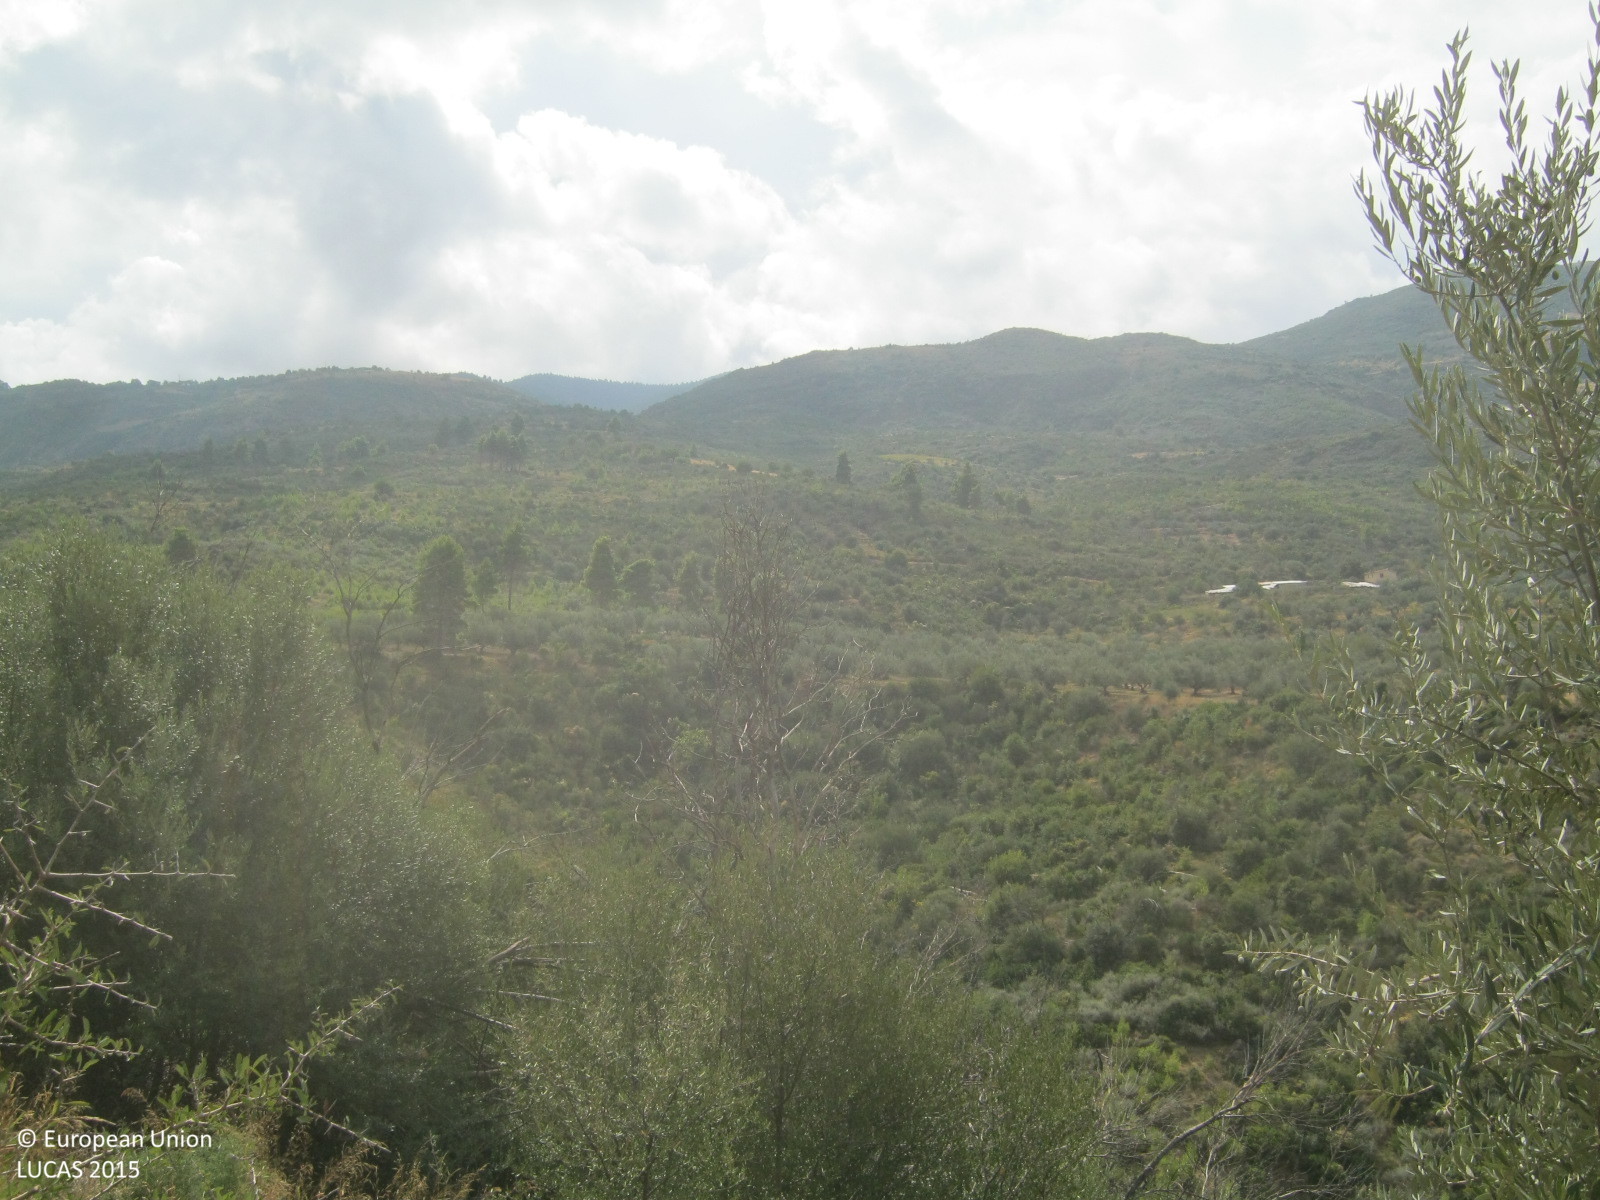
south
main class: Cropland
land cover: Olive groves
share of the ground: 50 - 75 %
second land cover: Spontaneously vegetated surfaces
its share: > 75 %
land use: Agriculture (excluding fallow land and kitchen gardens)
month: September
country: GR
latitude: 38.1505
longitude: 22.1908
